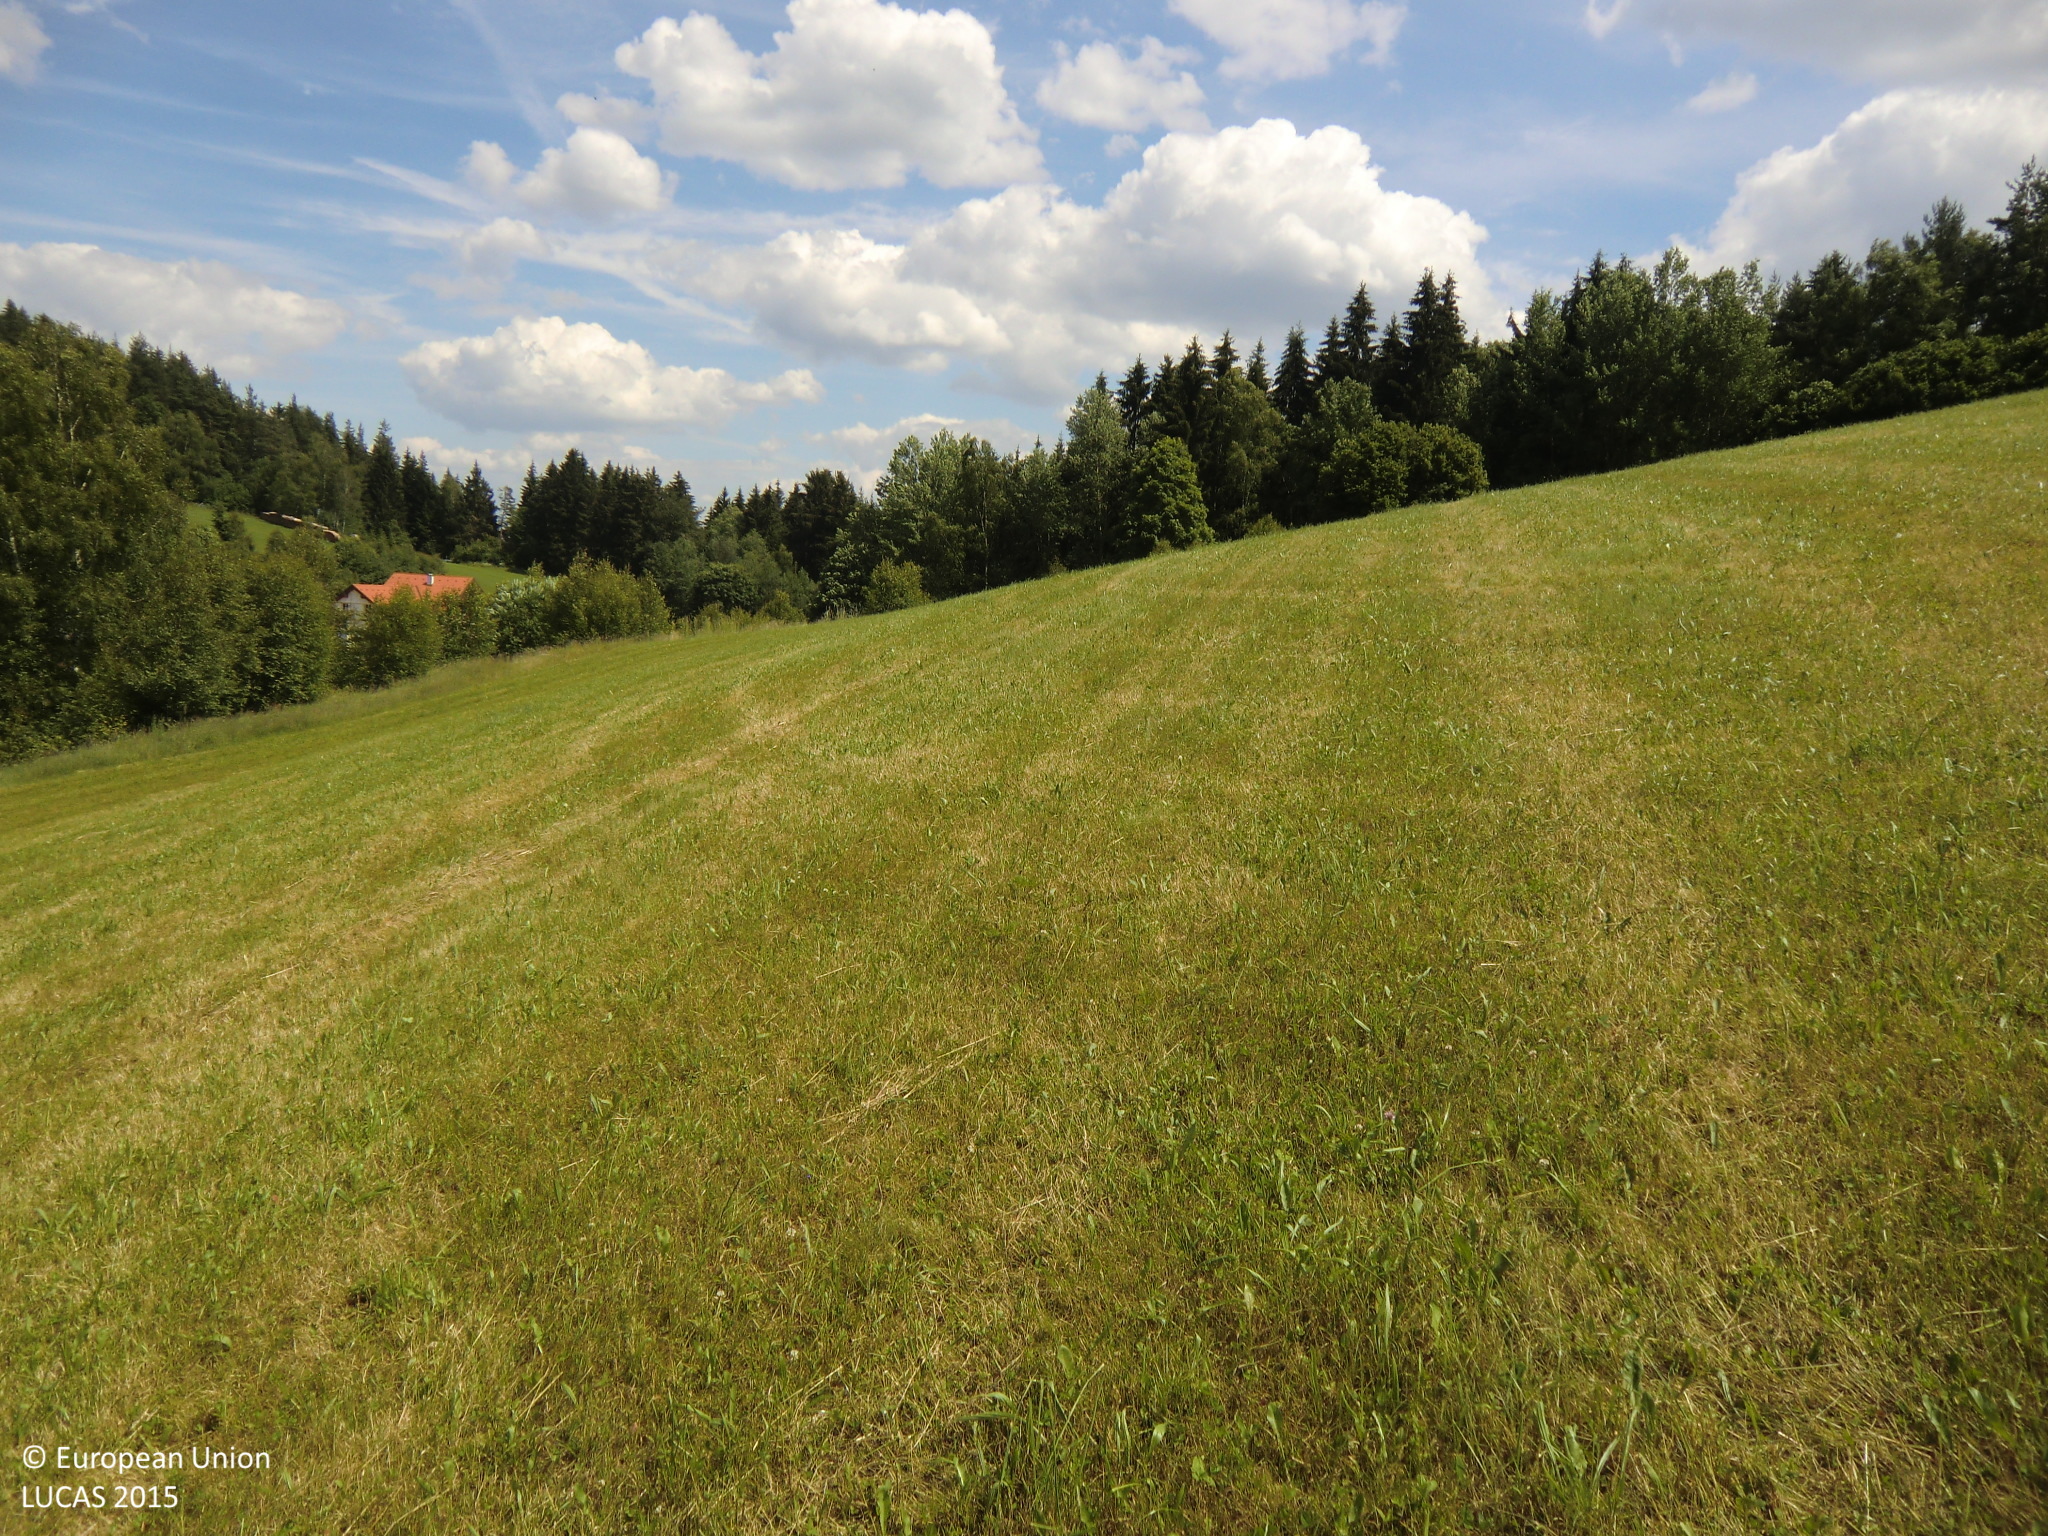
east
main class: Grassland
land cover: Grassland without tree/shrub cover
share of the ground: > 75 %
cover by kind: herbaceous plants 100 %
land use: Agriculture (excluding fallow land and kitchen gardens)
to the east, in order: Grassland without tree/shrub cover; Tracks; Grassland with sparse tree/shrub cover; Artificial constructions in urban areas; Broadleaved woodland; Spontaneously vegetated surfaces; Grassland without tree/shrub cover
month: June
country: AT
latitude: 48.5224
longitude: 15.0520
